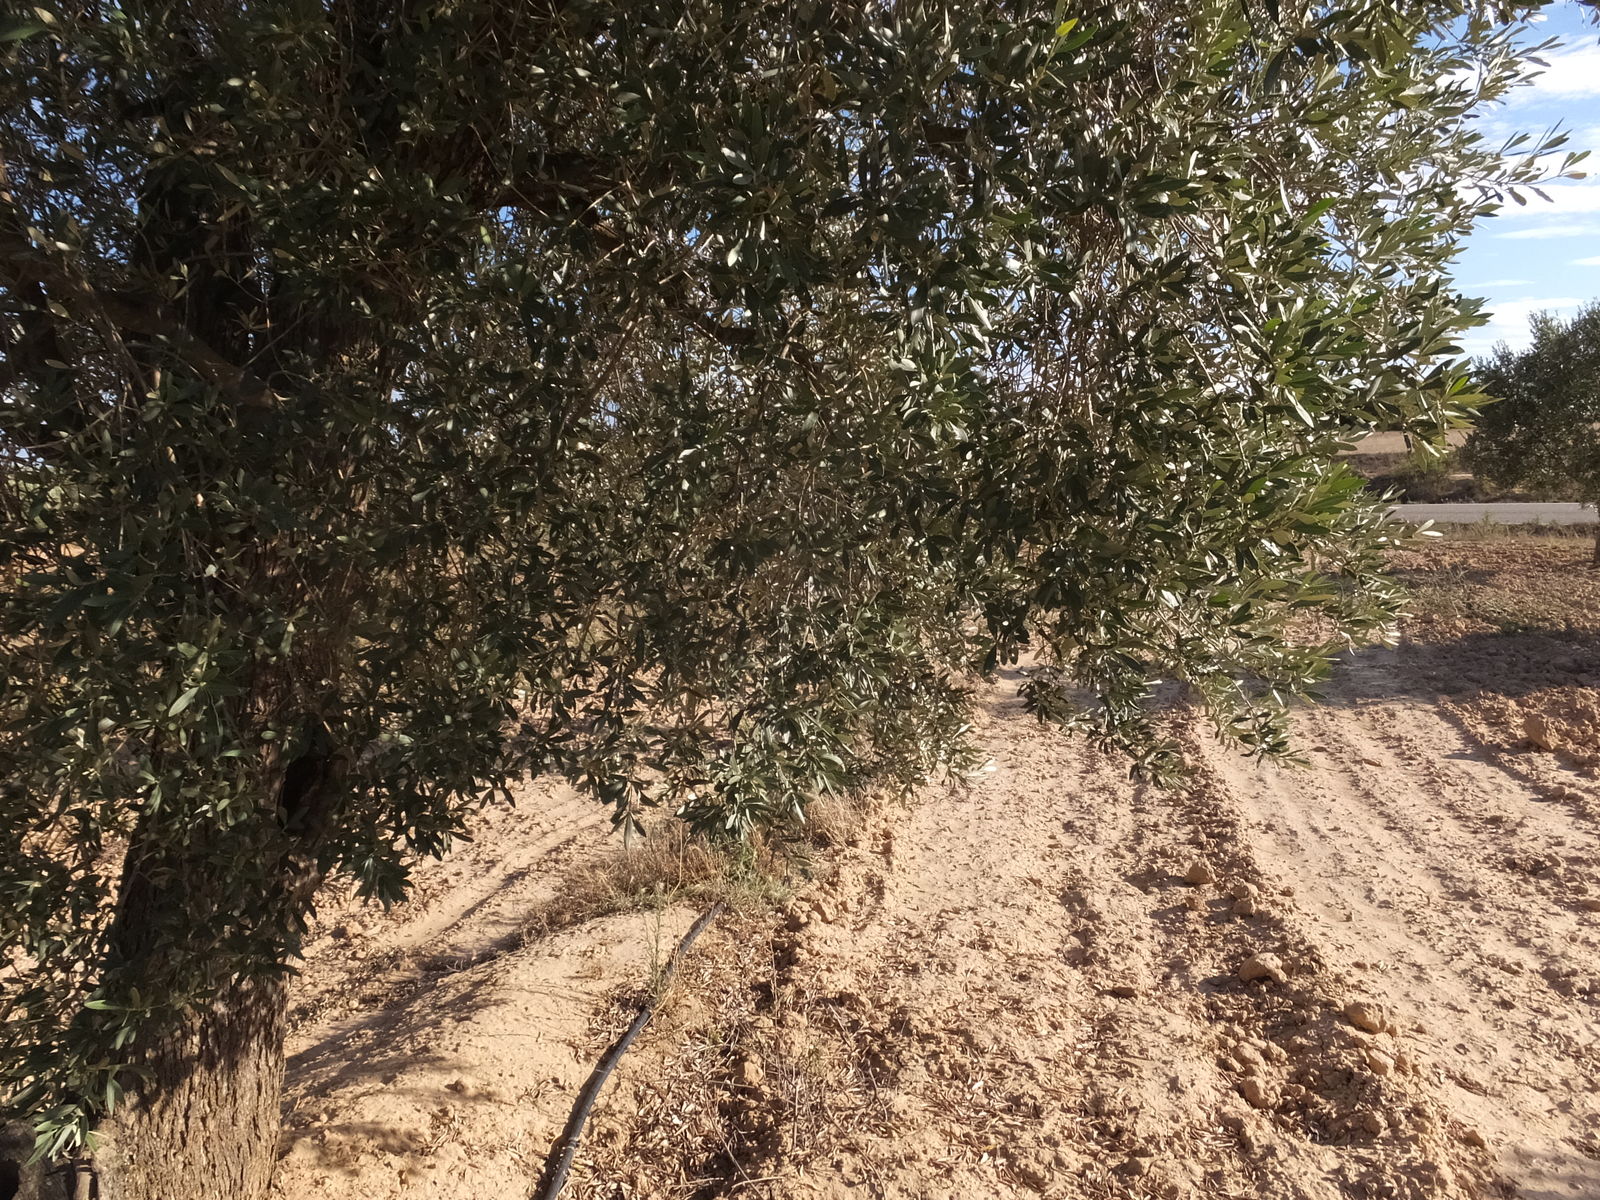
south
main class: Cropland
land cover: Olive groves
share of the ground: > 75 %
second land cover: Spontaneously vegetated surfaces
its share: < 10 %
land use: Agriculture (excluding fallow land and kitchen gardens)
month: August
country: ES
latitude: 41.2516
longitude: 0.2148
